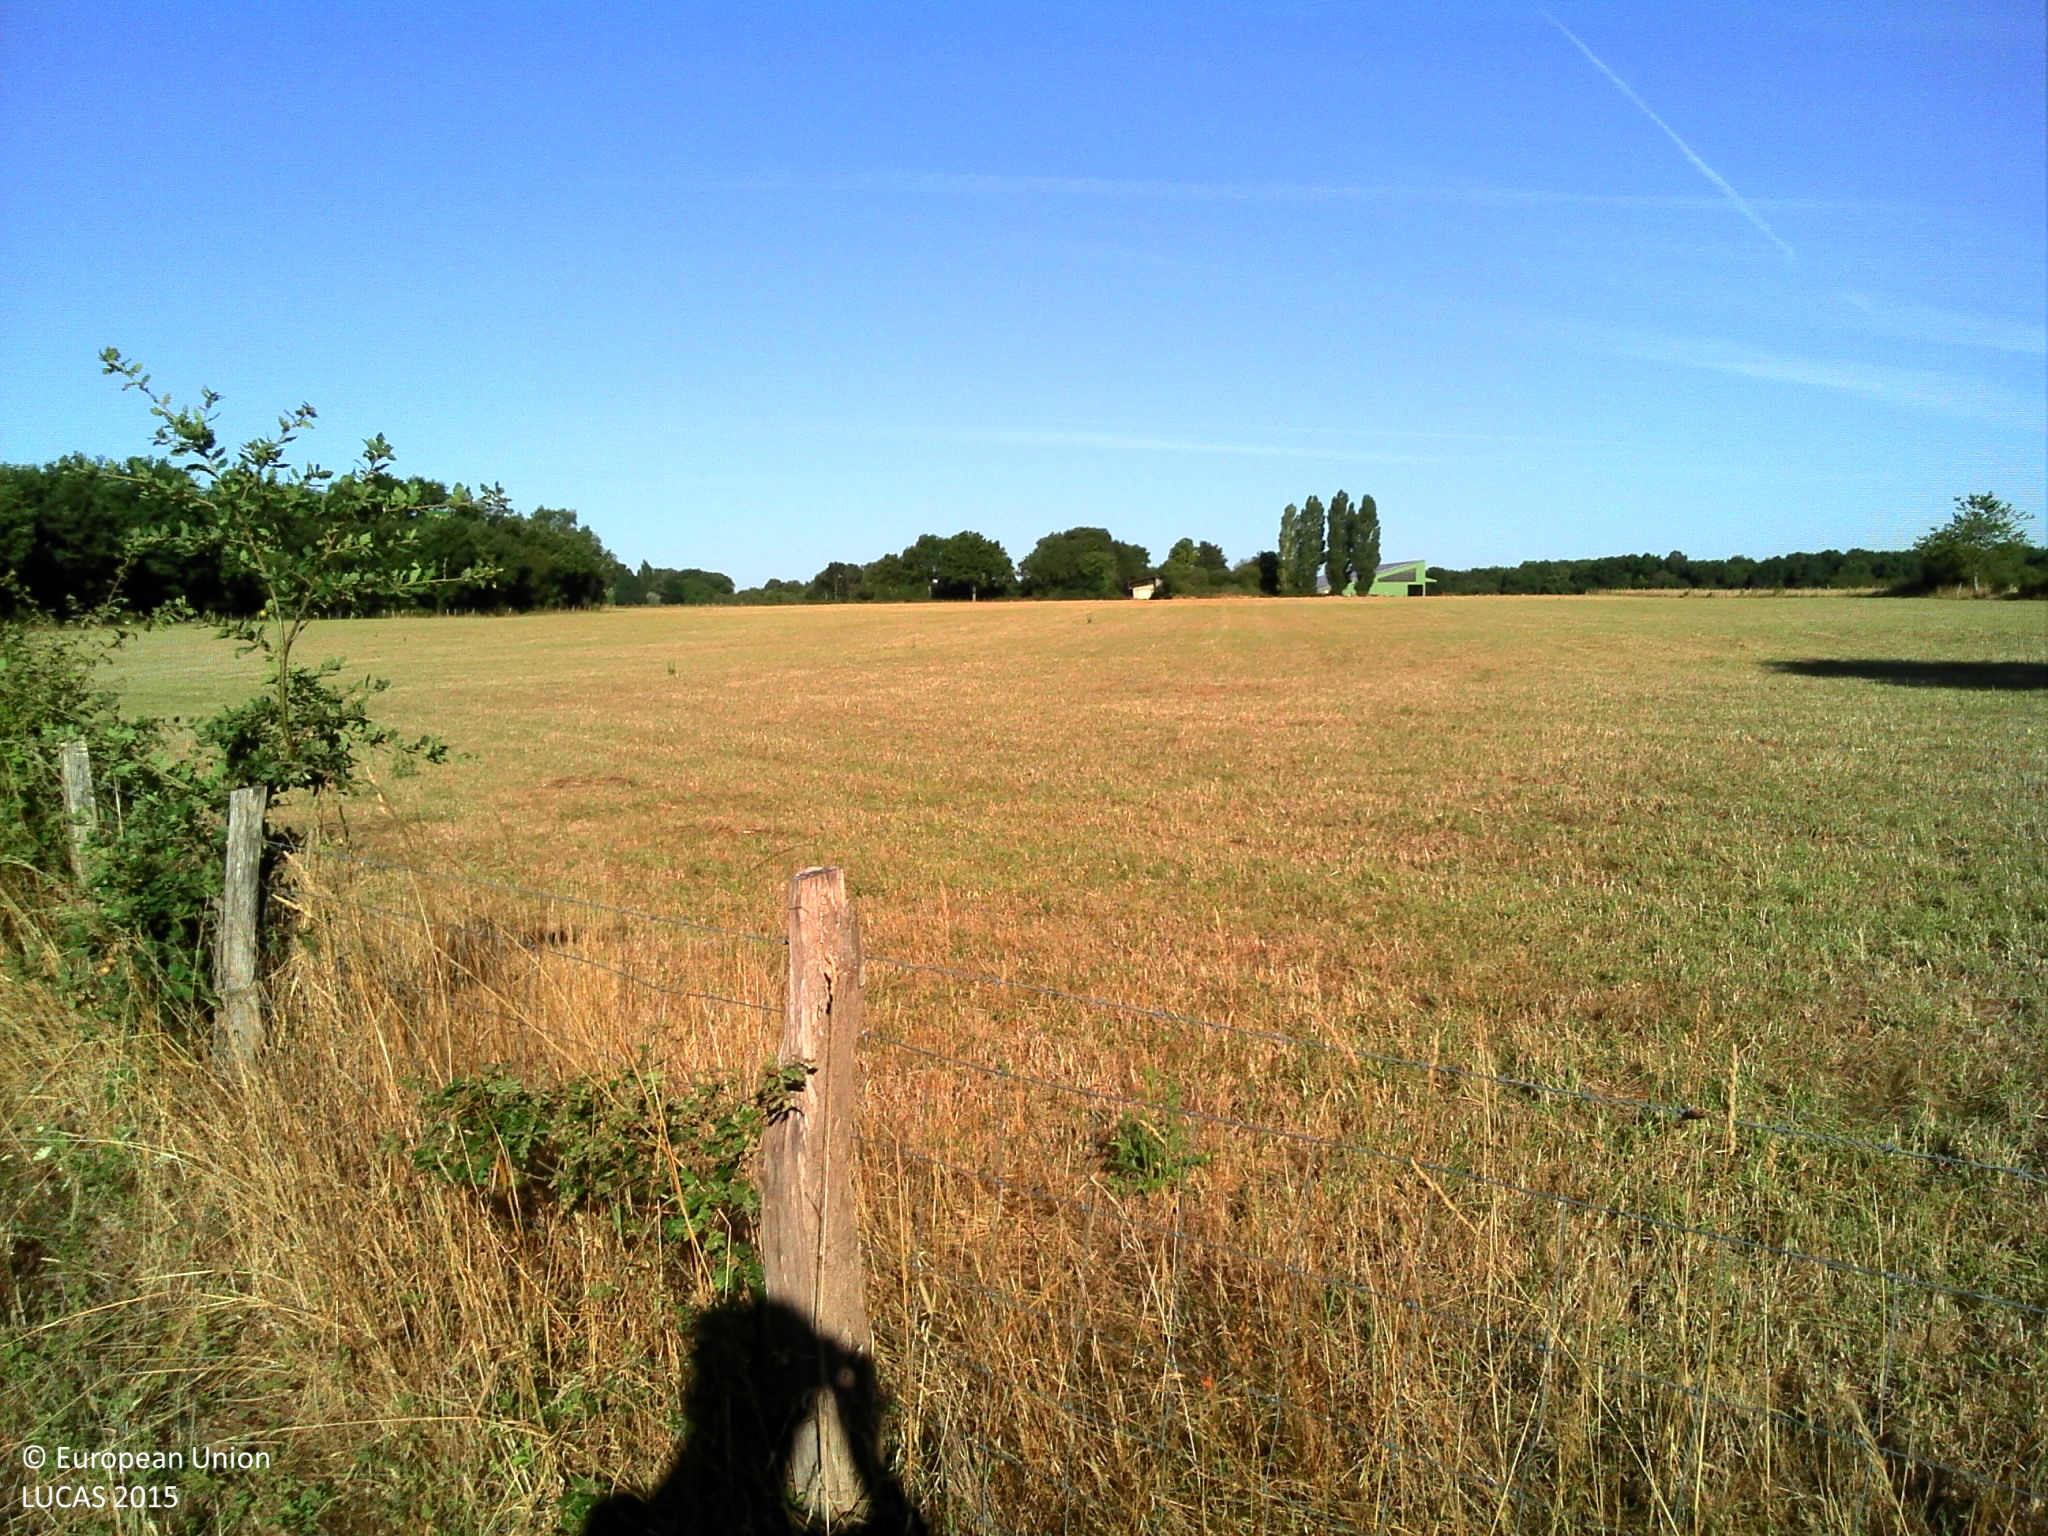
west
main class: Grassland
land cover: Grassland without tree/shrub cover
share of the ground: > 75 %
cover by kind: herbaceous plants 100 %
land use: Agriculture (excluding fallow land and kitchen gardens)
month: July
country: FR
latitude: 46.4036
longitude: 0.5531
